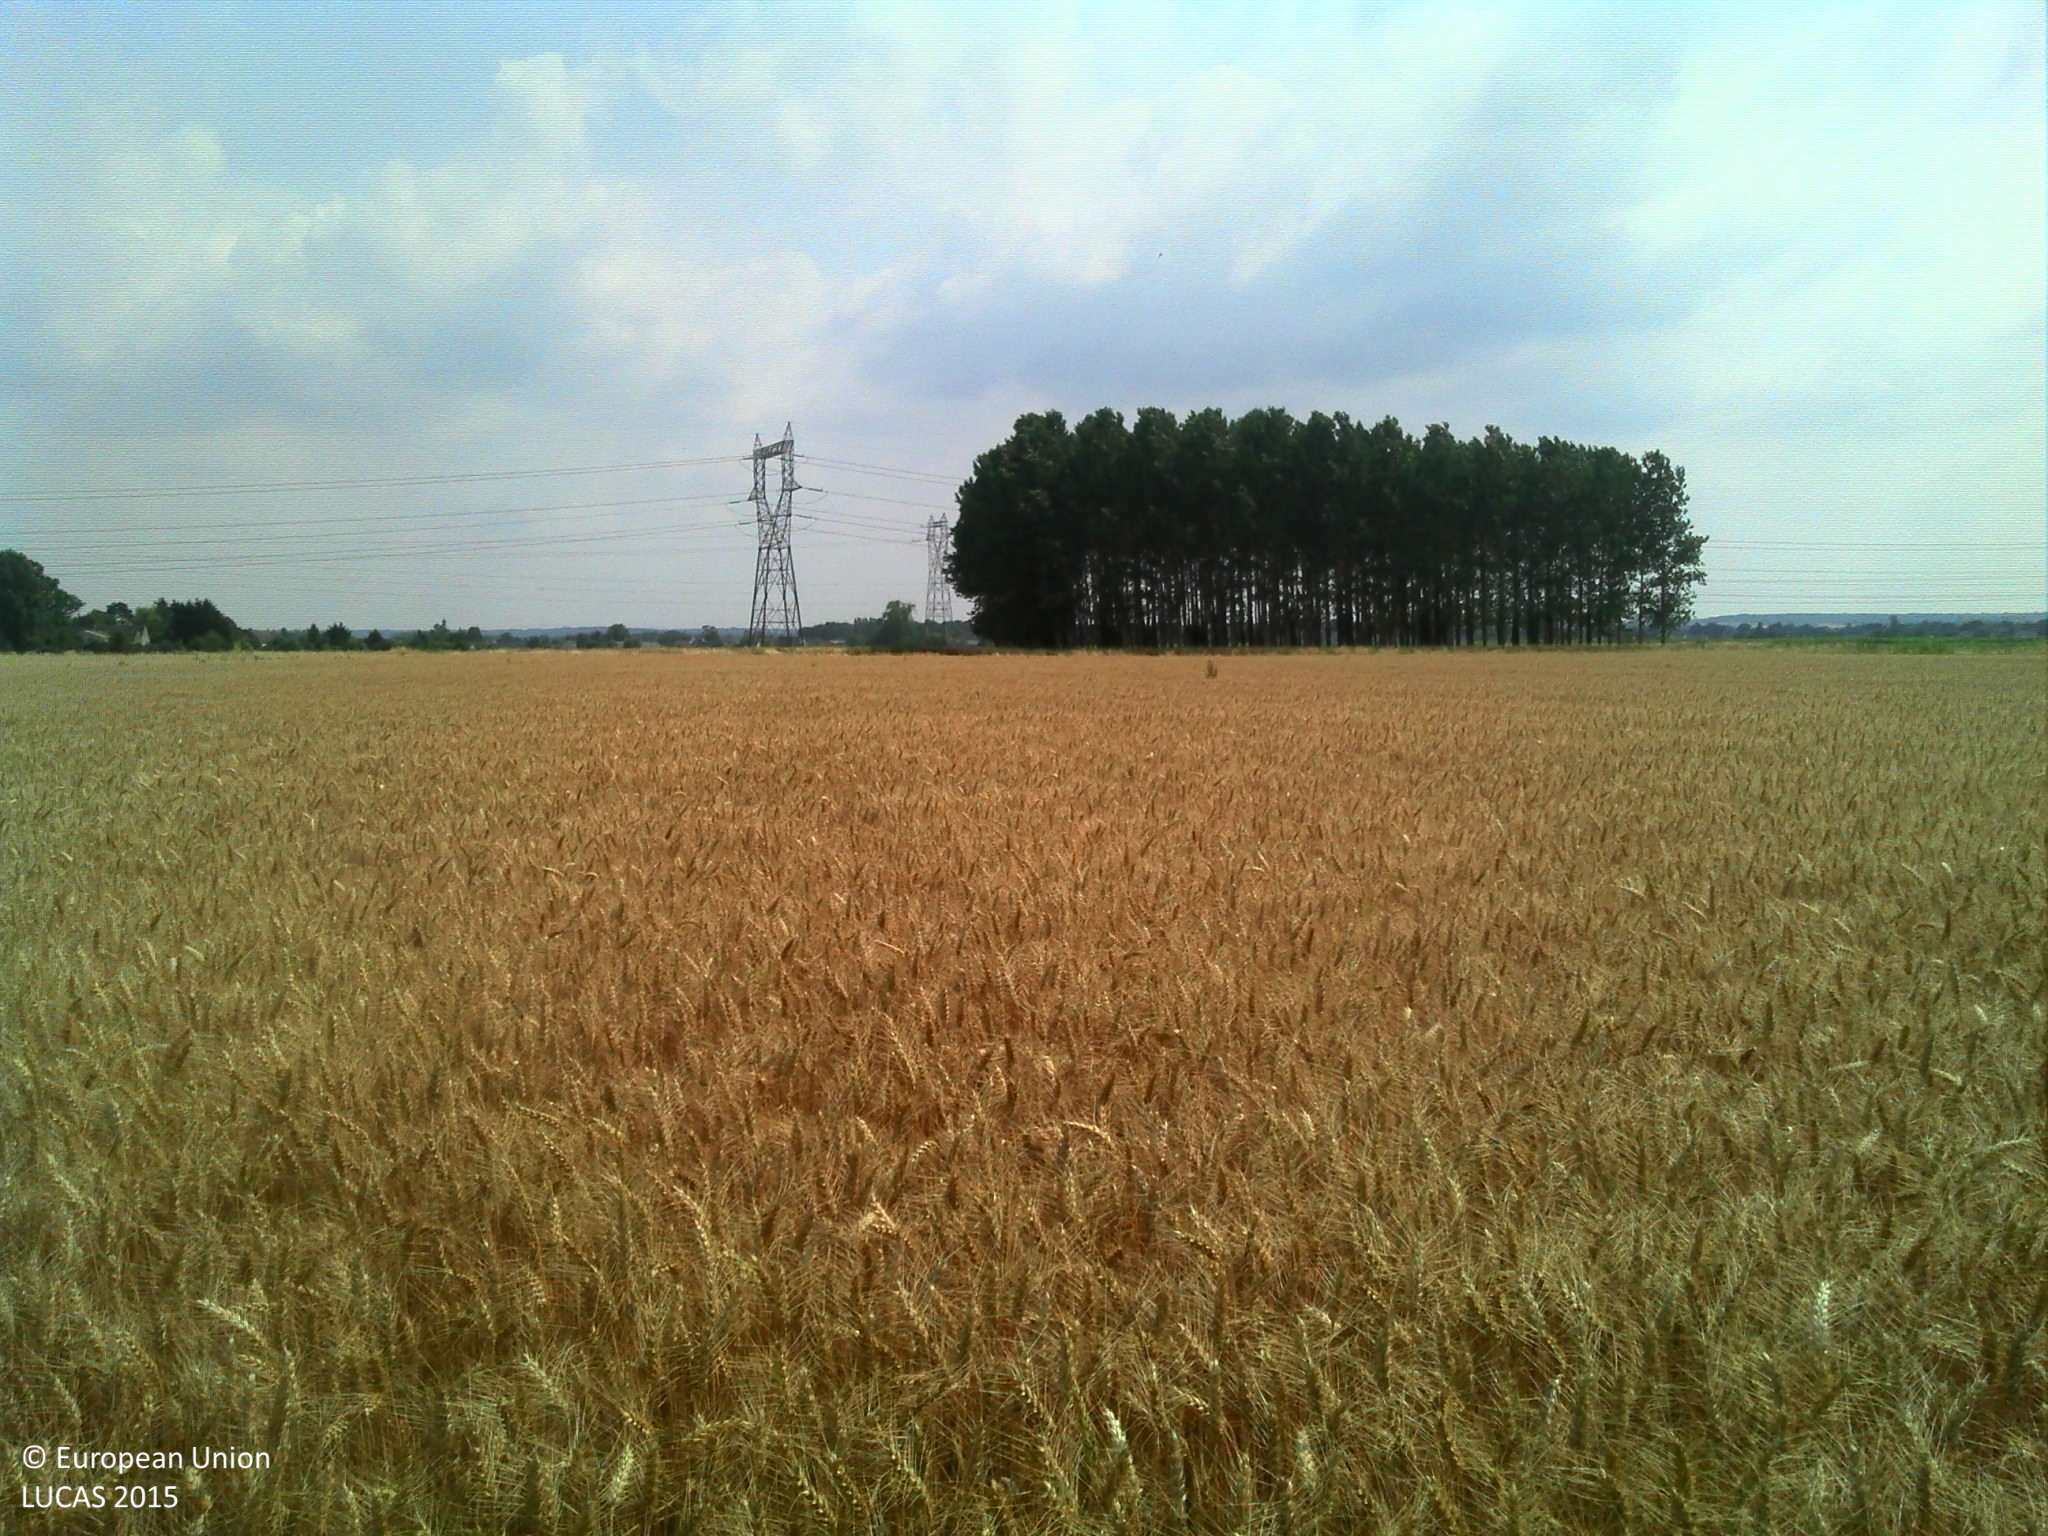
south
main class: Cropland
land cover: Durum wheat
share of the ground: > 75 %
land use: Agriculture (excluding fallow land and kitchen gardens)
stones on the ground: < 10 %
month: July
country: FR
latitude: 47.2184
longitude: 0.1388
